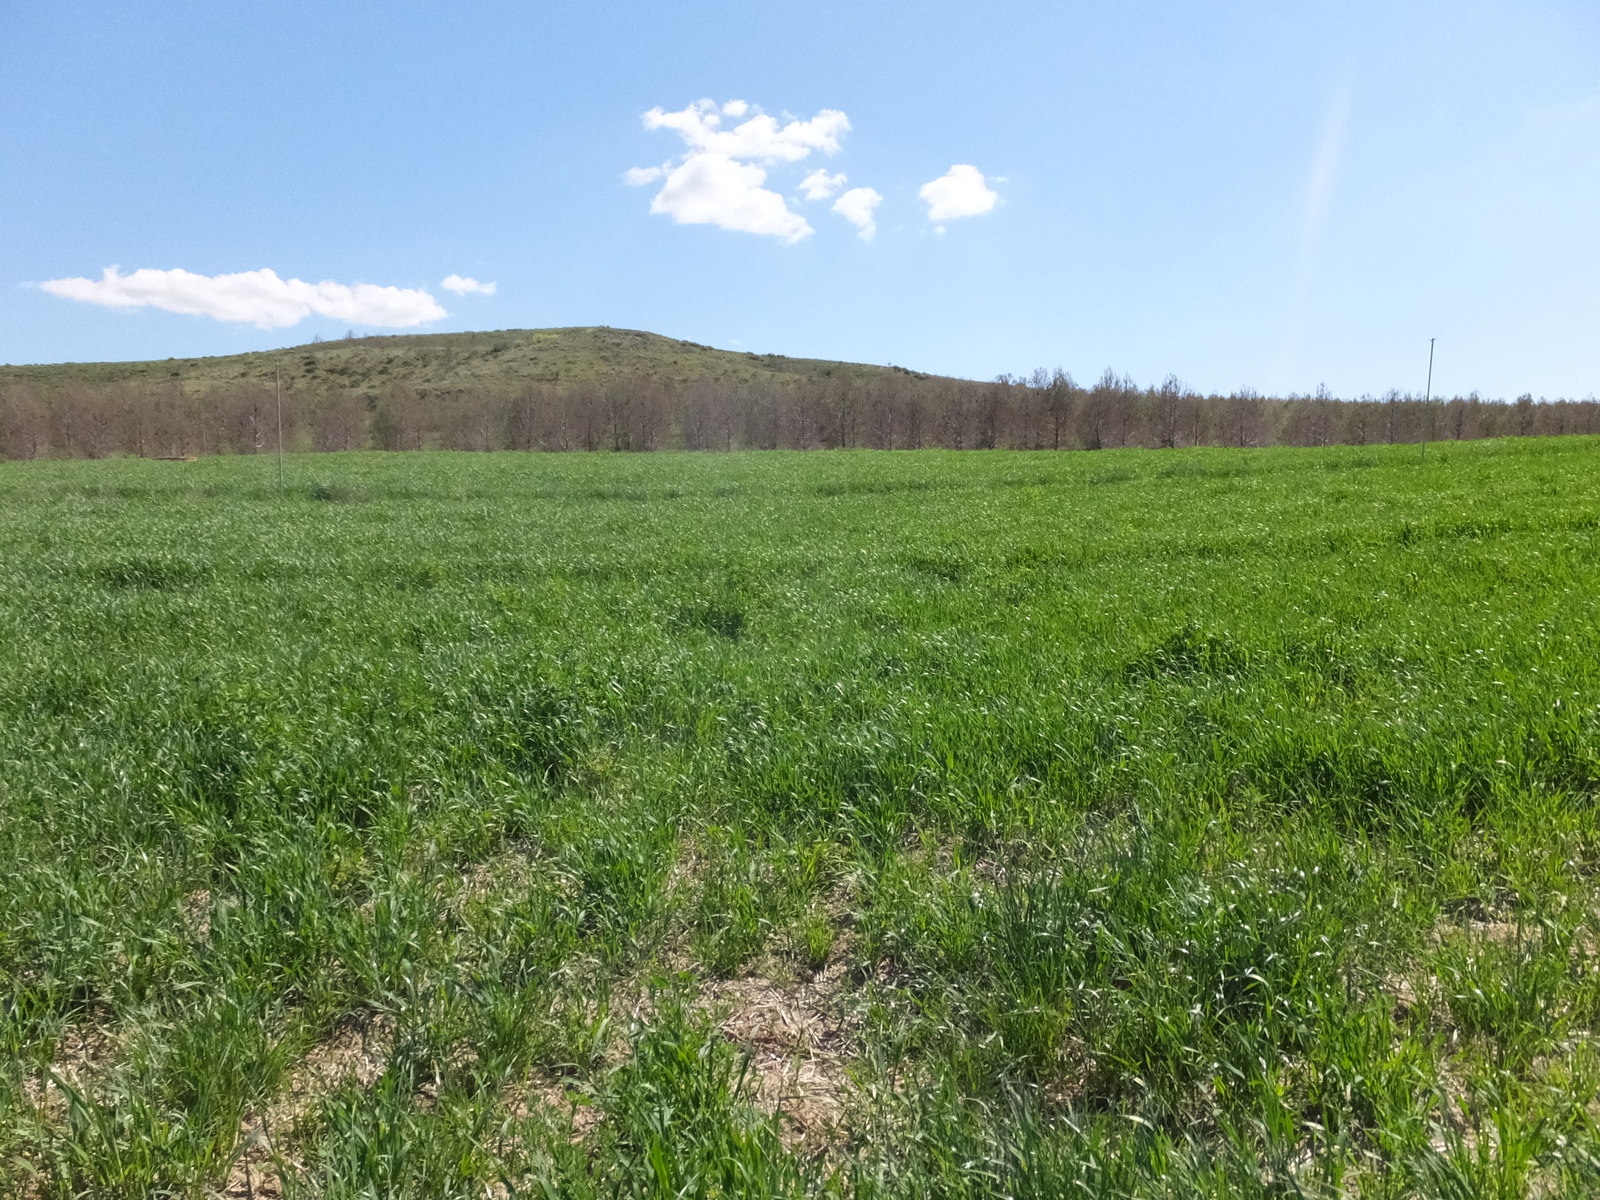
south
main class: Cropland
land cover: Durum wheat
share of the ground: > 75 %
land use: Agriculture (excluding fallow land and kitchen gardens)
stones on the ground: < 10 %
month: April
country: ES
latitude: 41.7122
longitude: -0.2700
